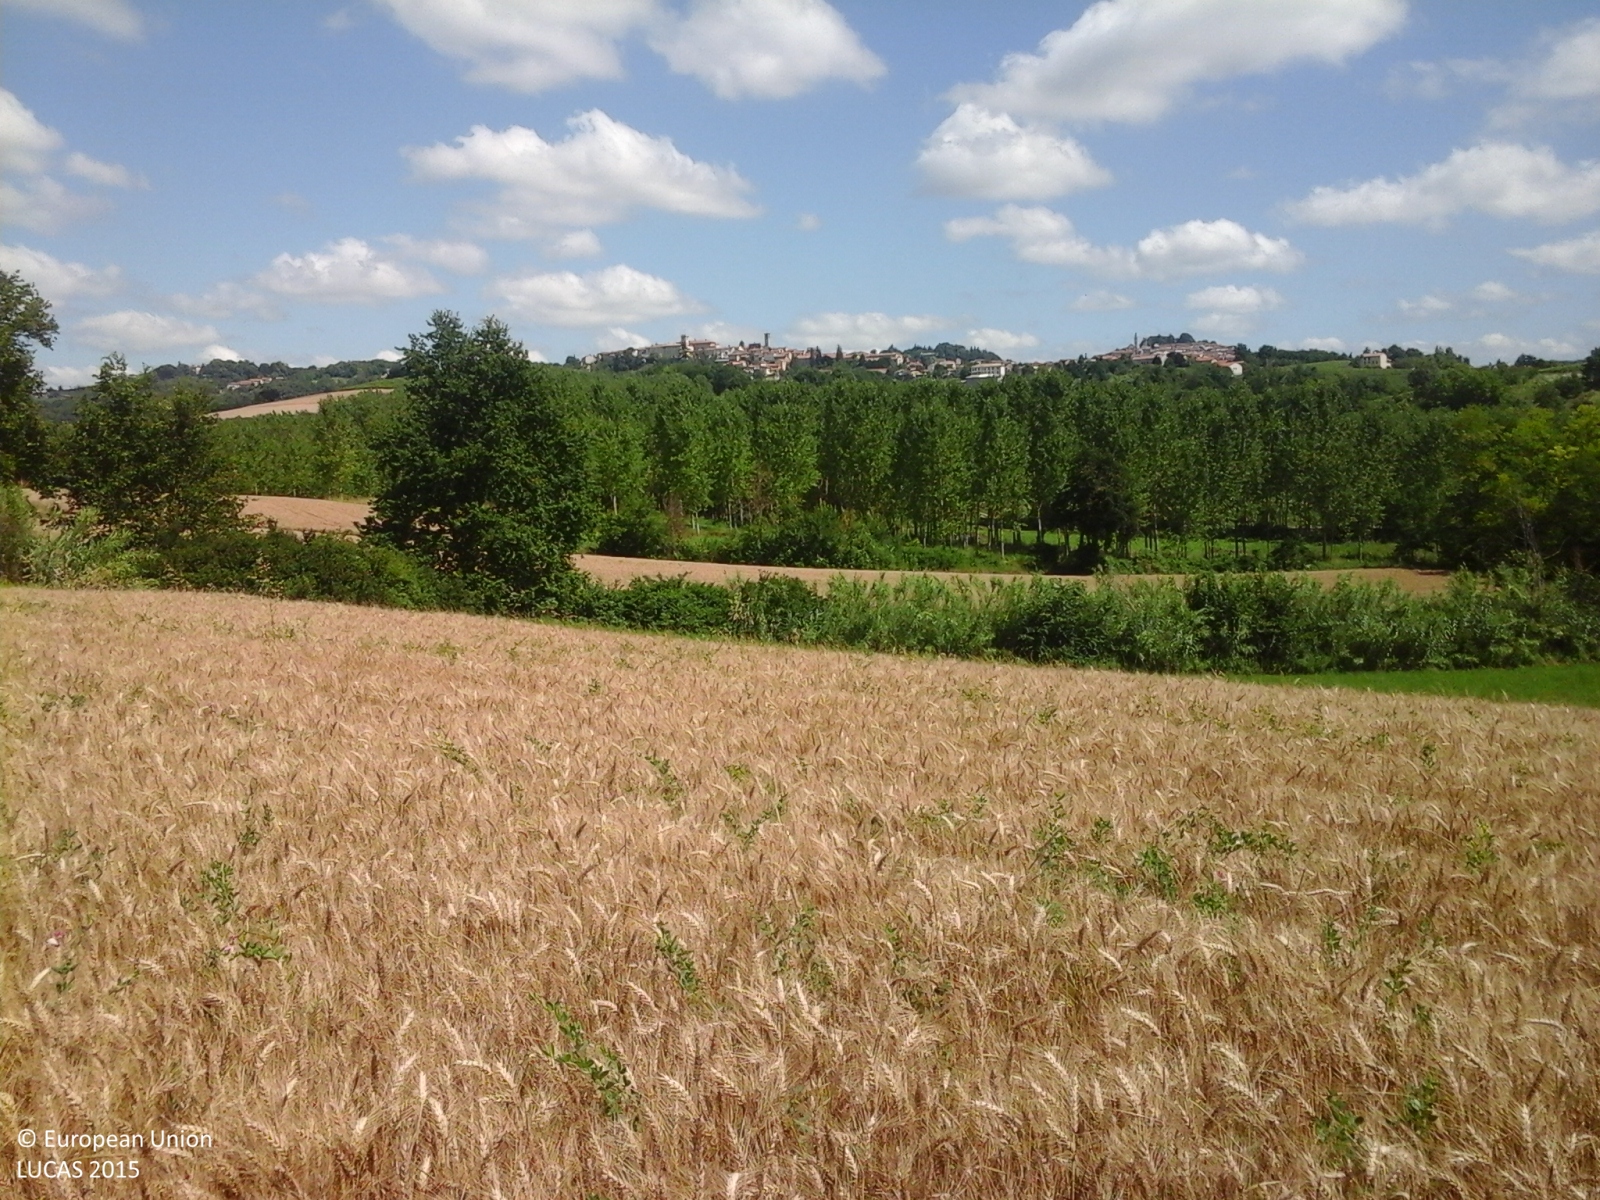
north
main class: Cropland
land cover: Common wheat
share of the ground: > 75 %
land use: Agriculture (excluding fallow land and kitchen gardens)
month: June
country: IT
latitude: 45.0595
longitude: 8.3902
